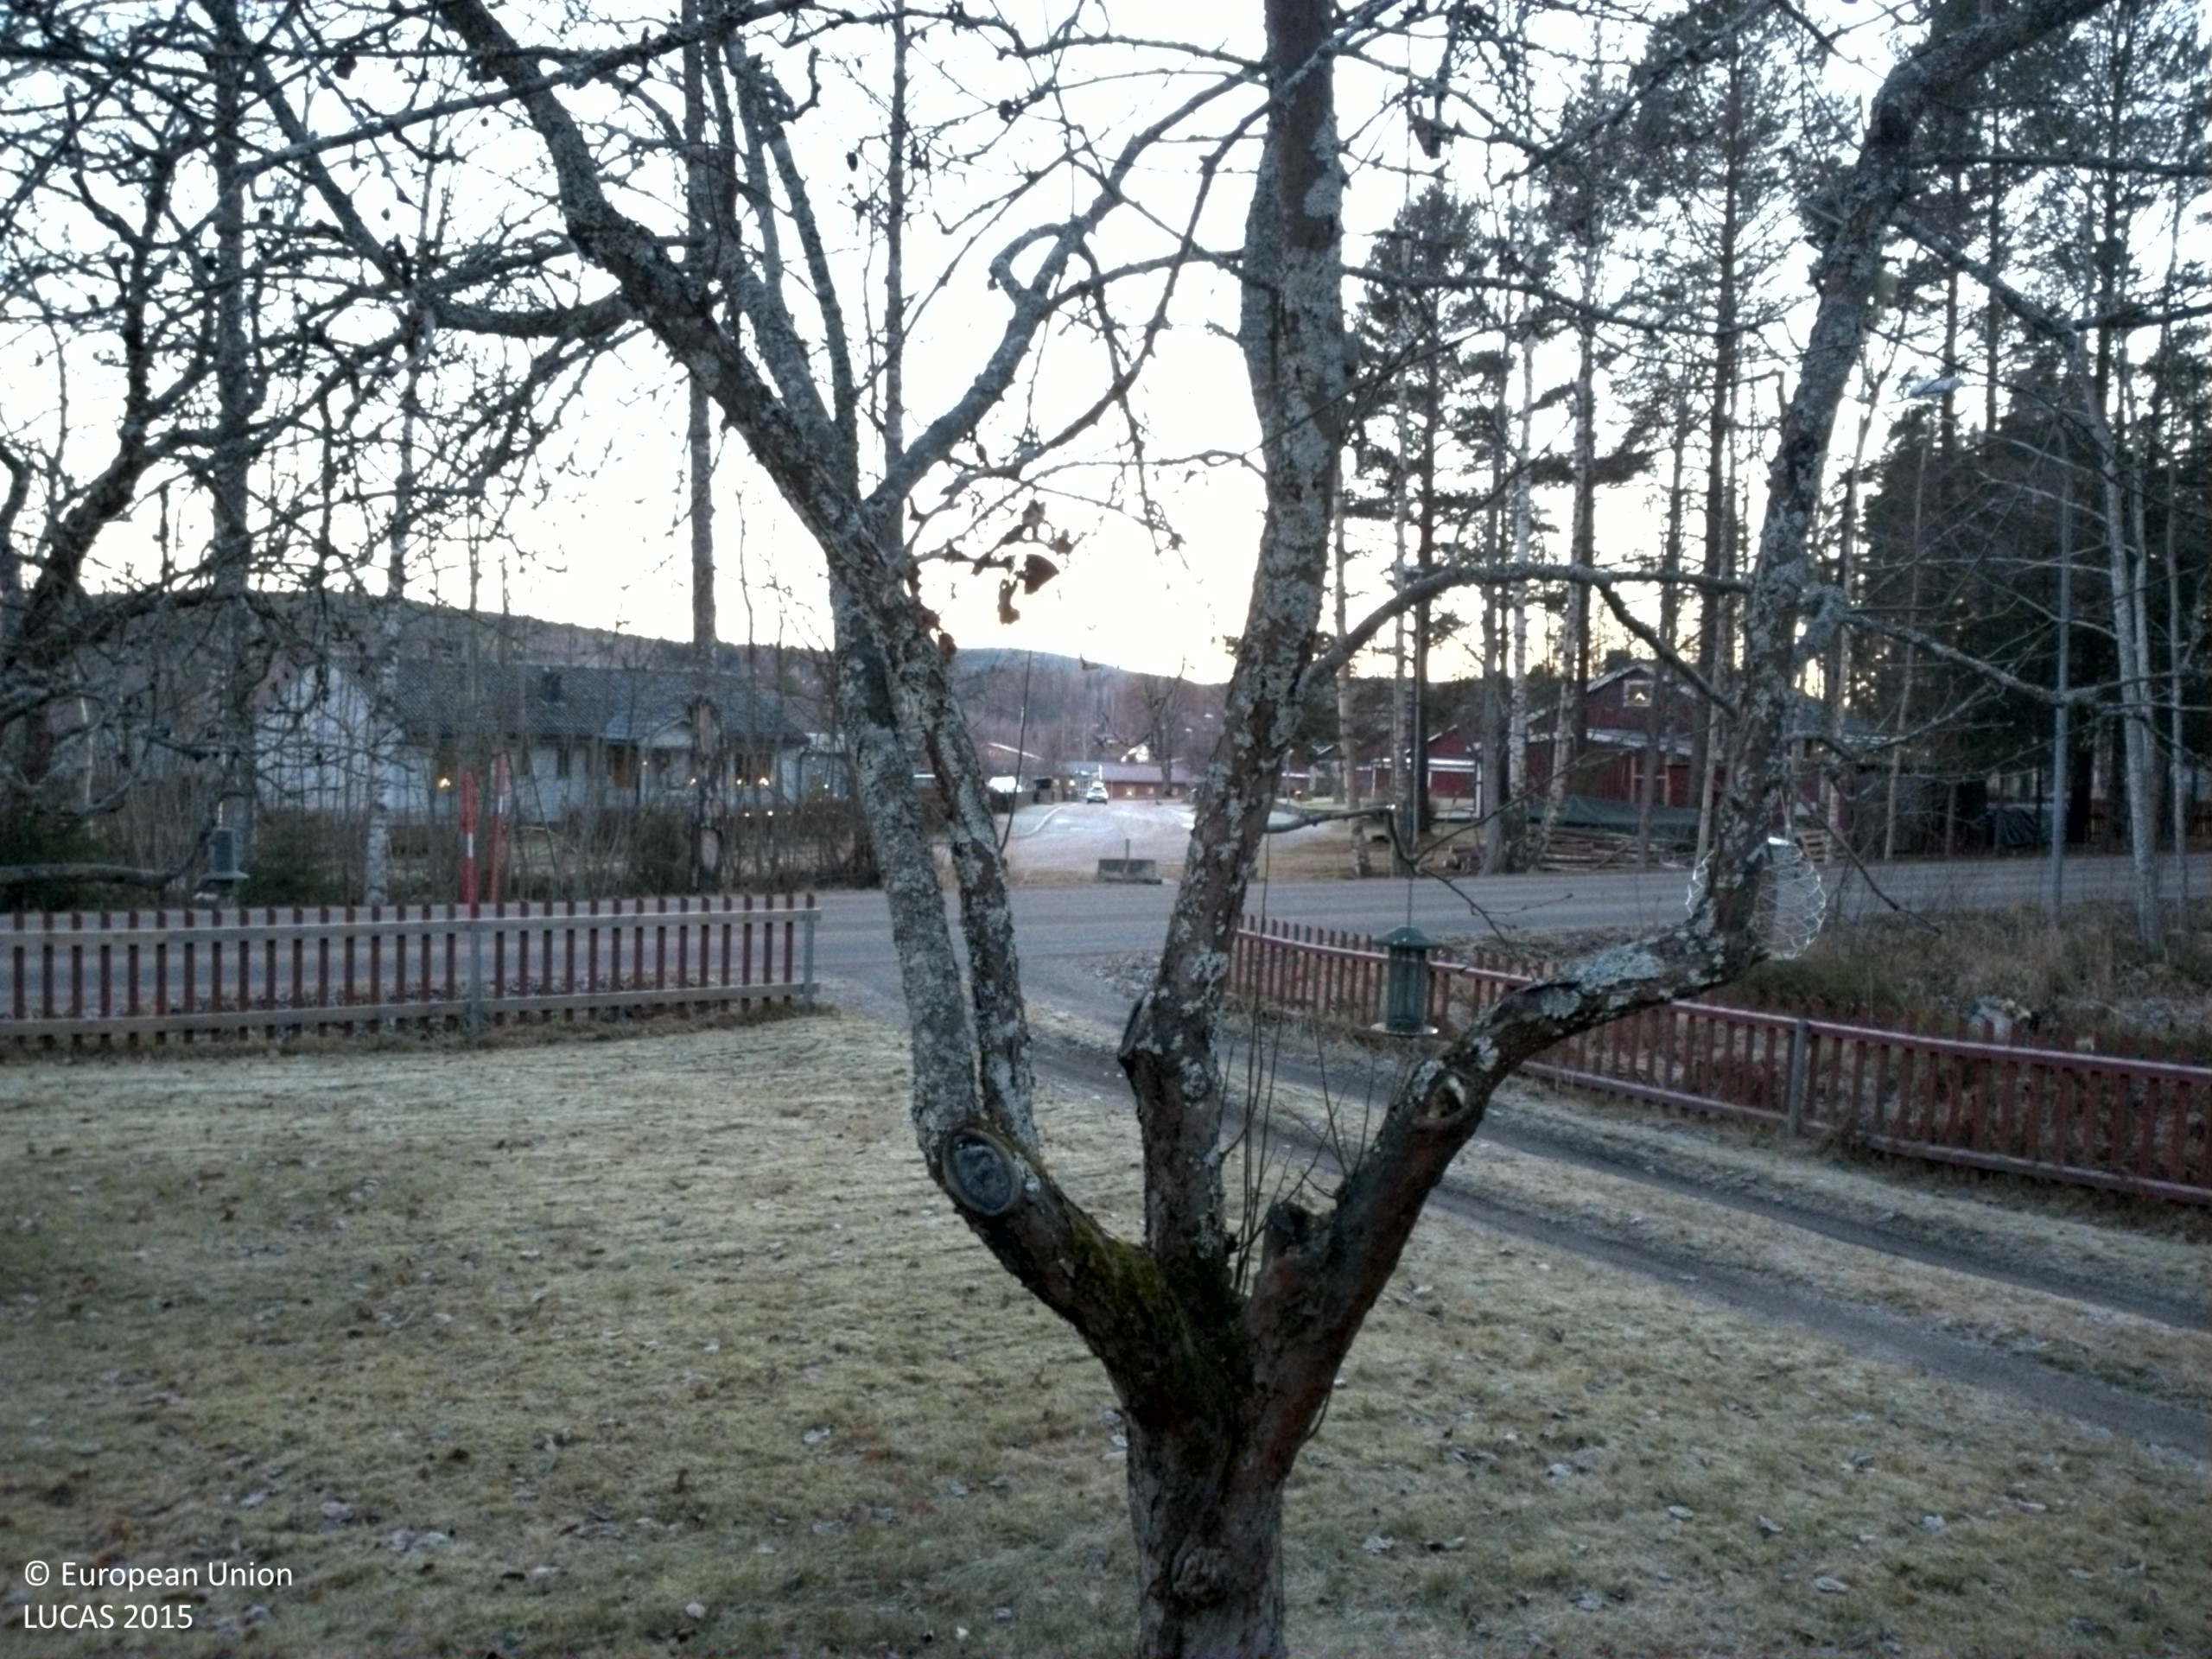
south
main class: Woodland
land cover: Broadleaved woodland
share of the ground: 10 - 25 %
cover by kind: herbaceous plants 85 %, broadleaved forest trees 15 %
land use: Residential
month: November
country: SE
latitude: 61.2630
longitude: 16.8284
